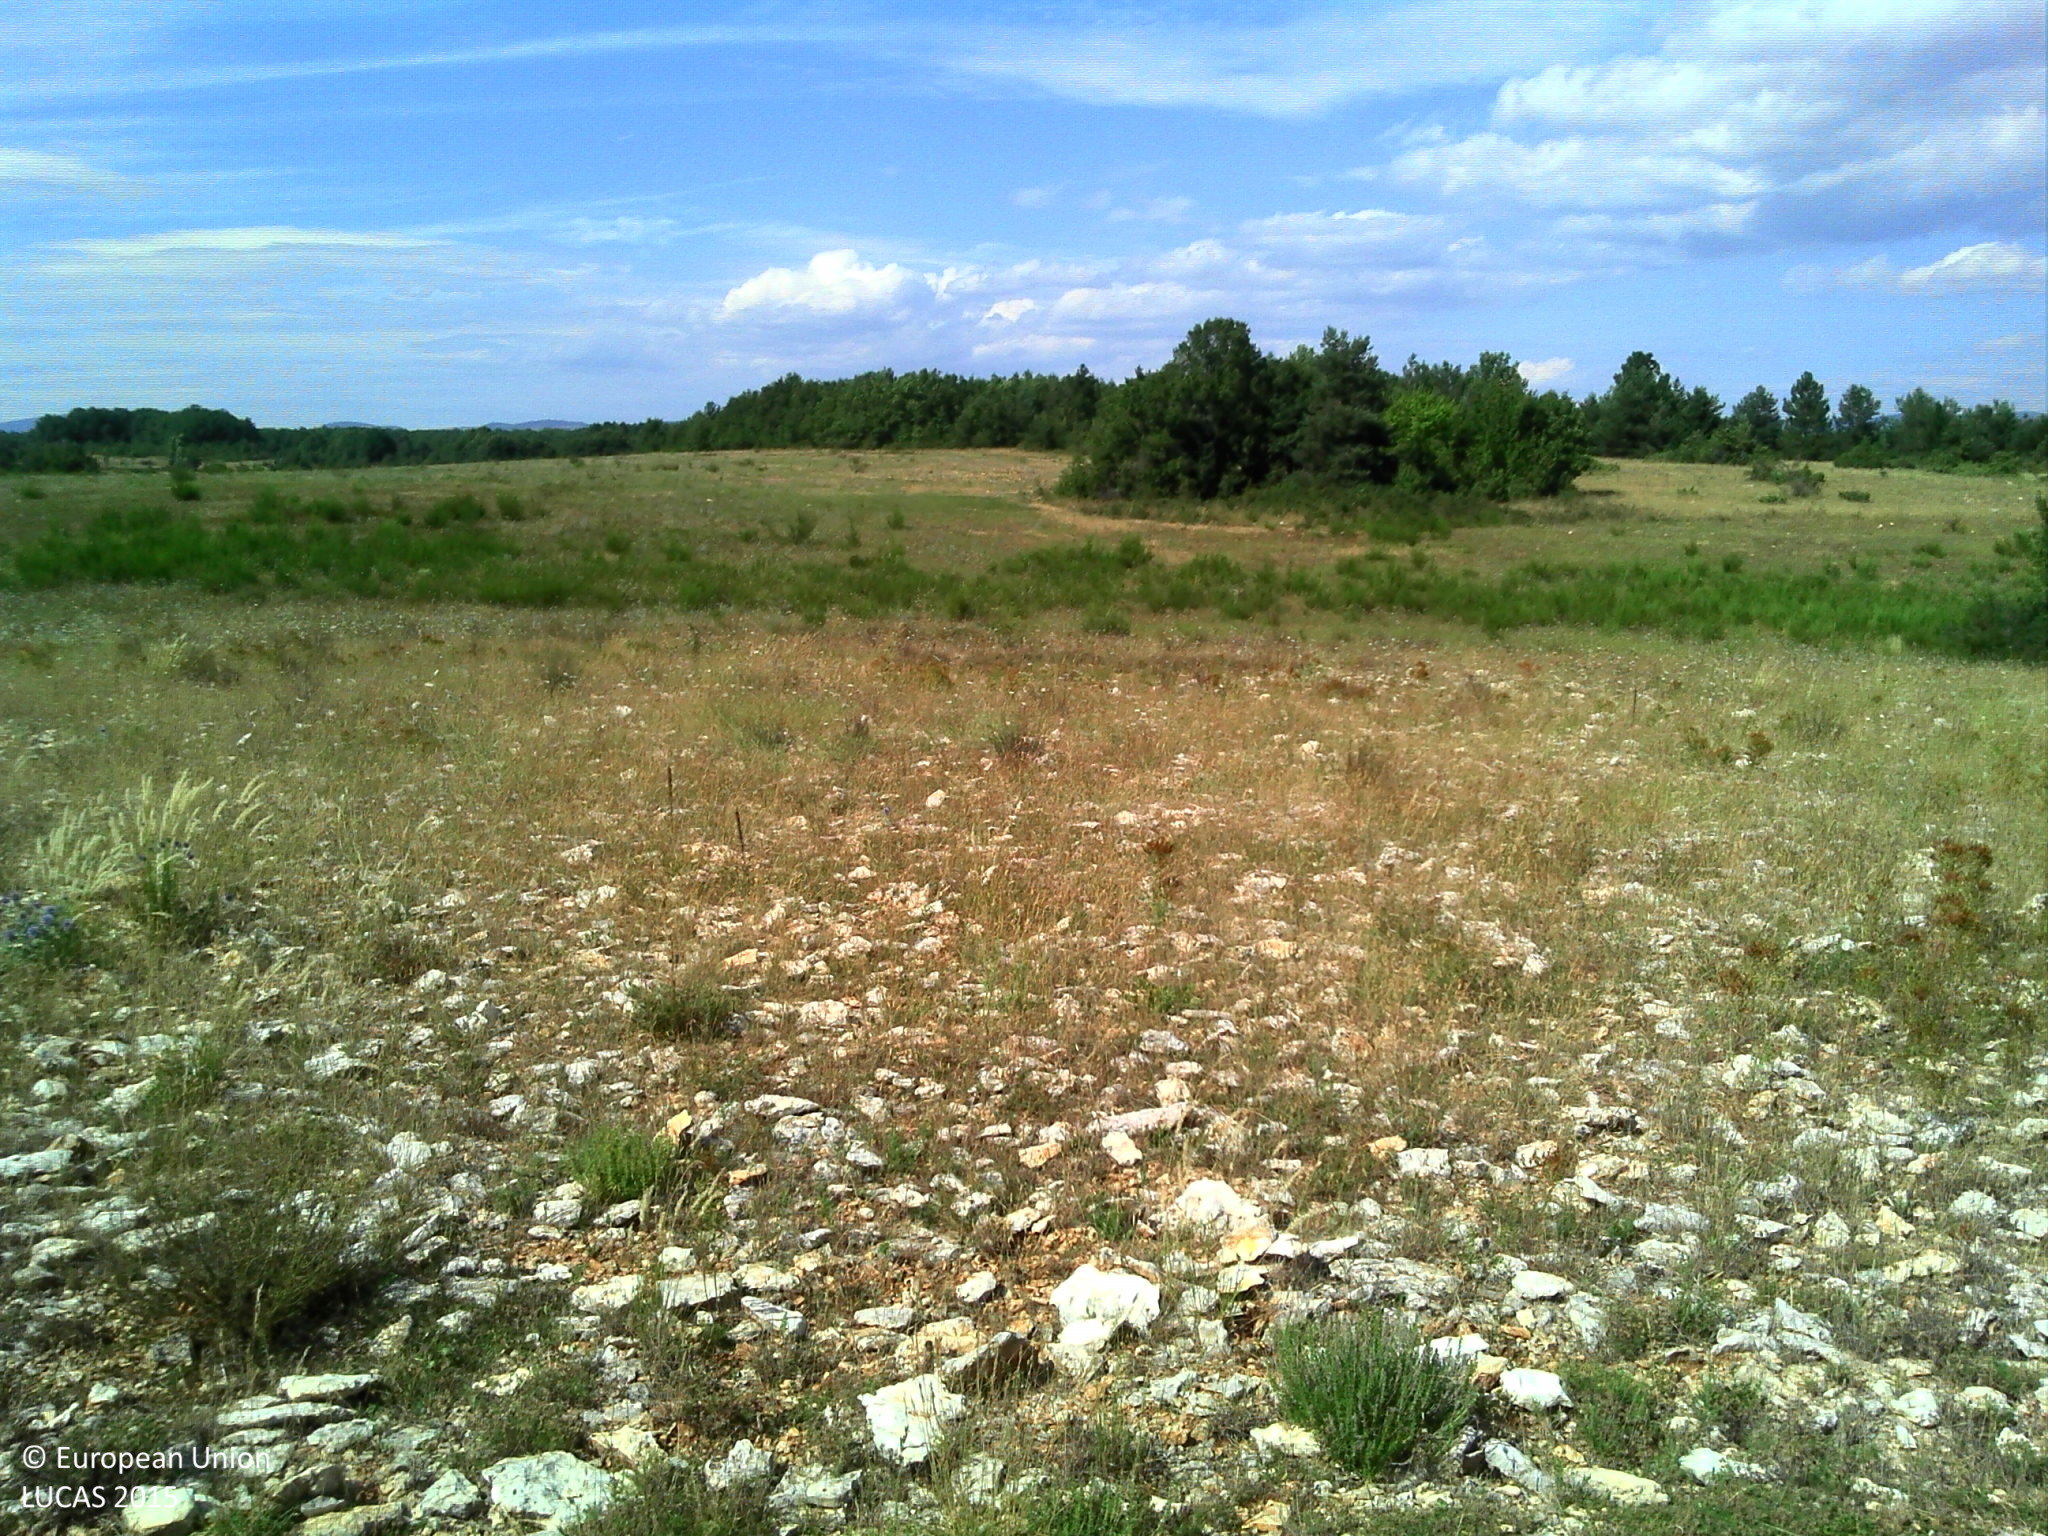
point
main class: Grassland
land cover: Spontaneously vegetated surfaces
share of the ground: > 75 %
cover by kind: herbaceous plants 70 %, unconsolidated bare surface 25 %, shrubs 5 %
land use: Semi-natural and natural areas not in use
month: July
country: FR
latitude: 44.0194
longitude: 5.5297
